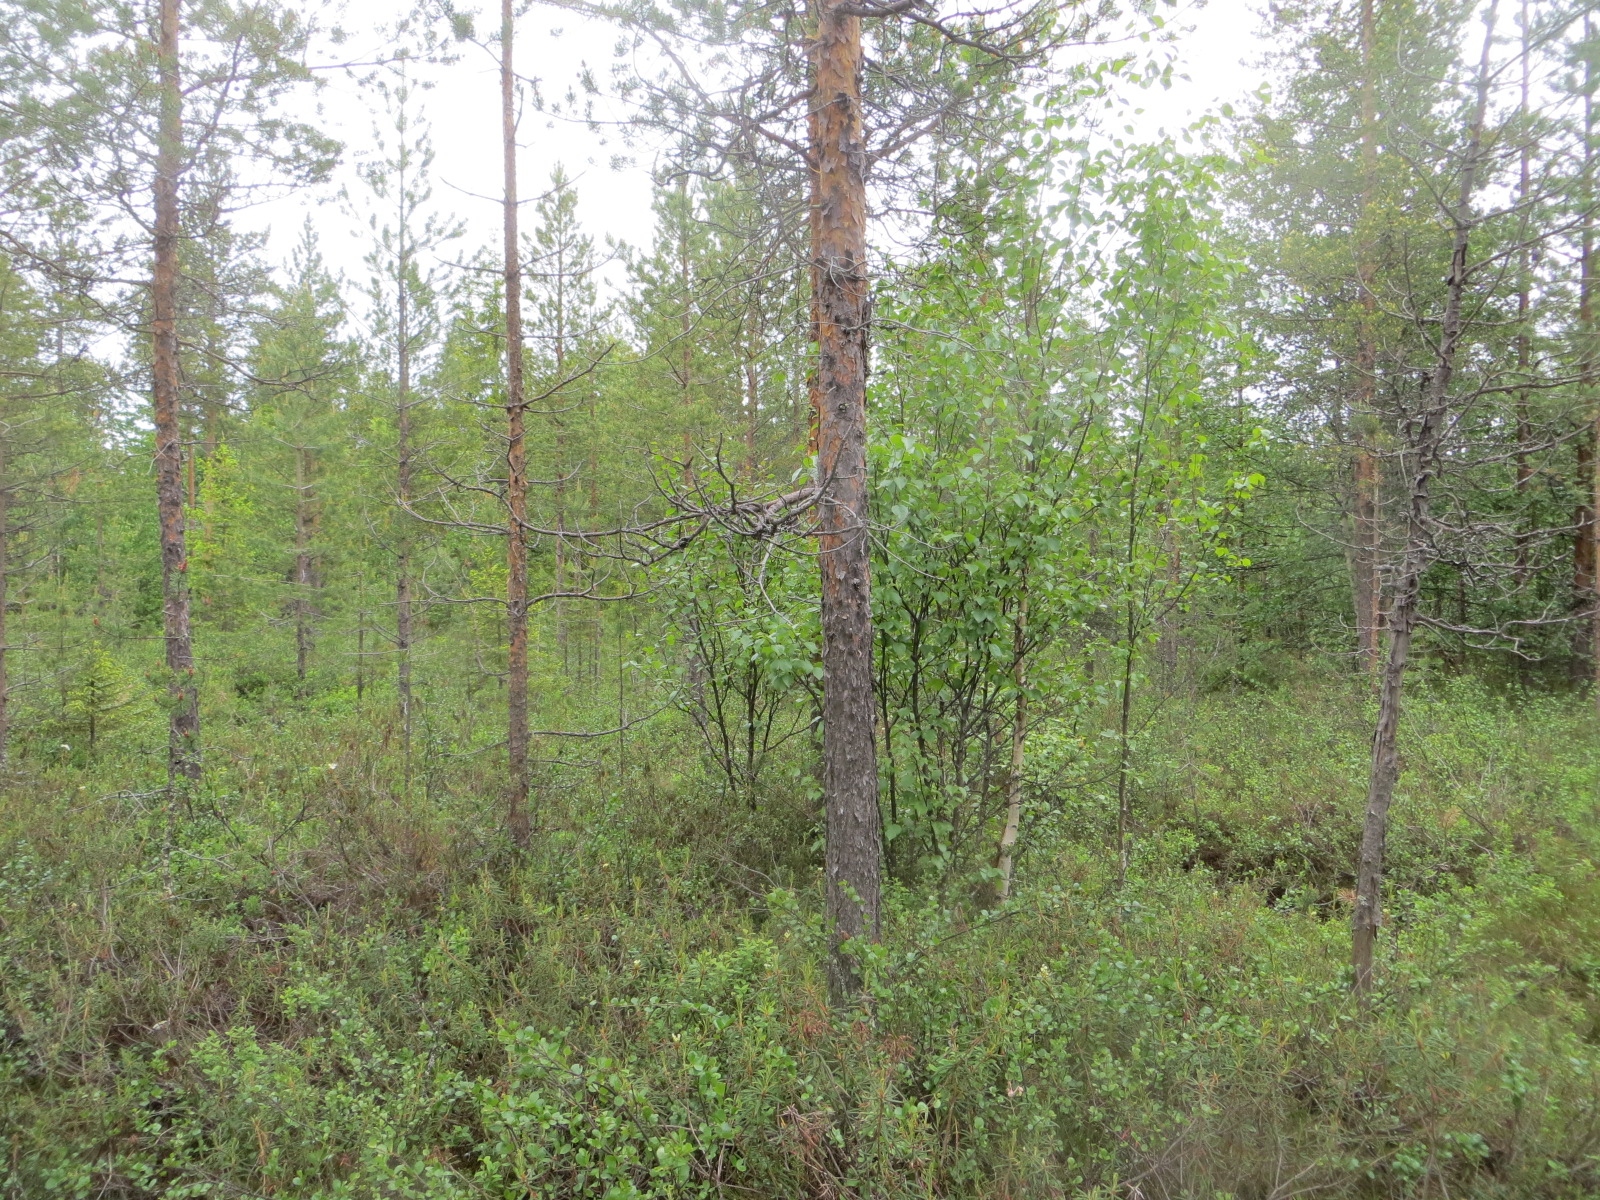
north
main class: Woodland
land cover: Pine dominated coniferous woodland
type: boreal forest
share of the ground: > 75 %
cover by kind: coniferous forest trees 75 %, shrubs 25 %
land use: Forestry
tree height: > 5 m
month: June
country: FI
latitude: 66.5906
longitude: 24.6855
